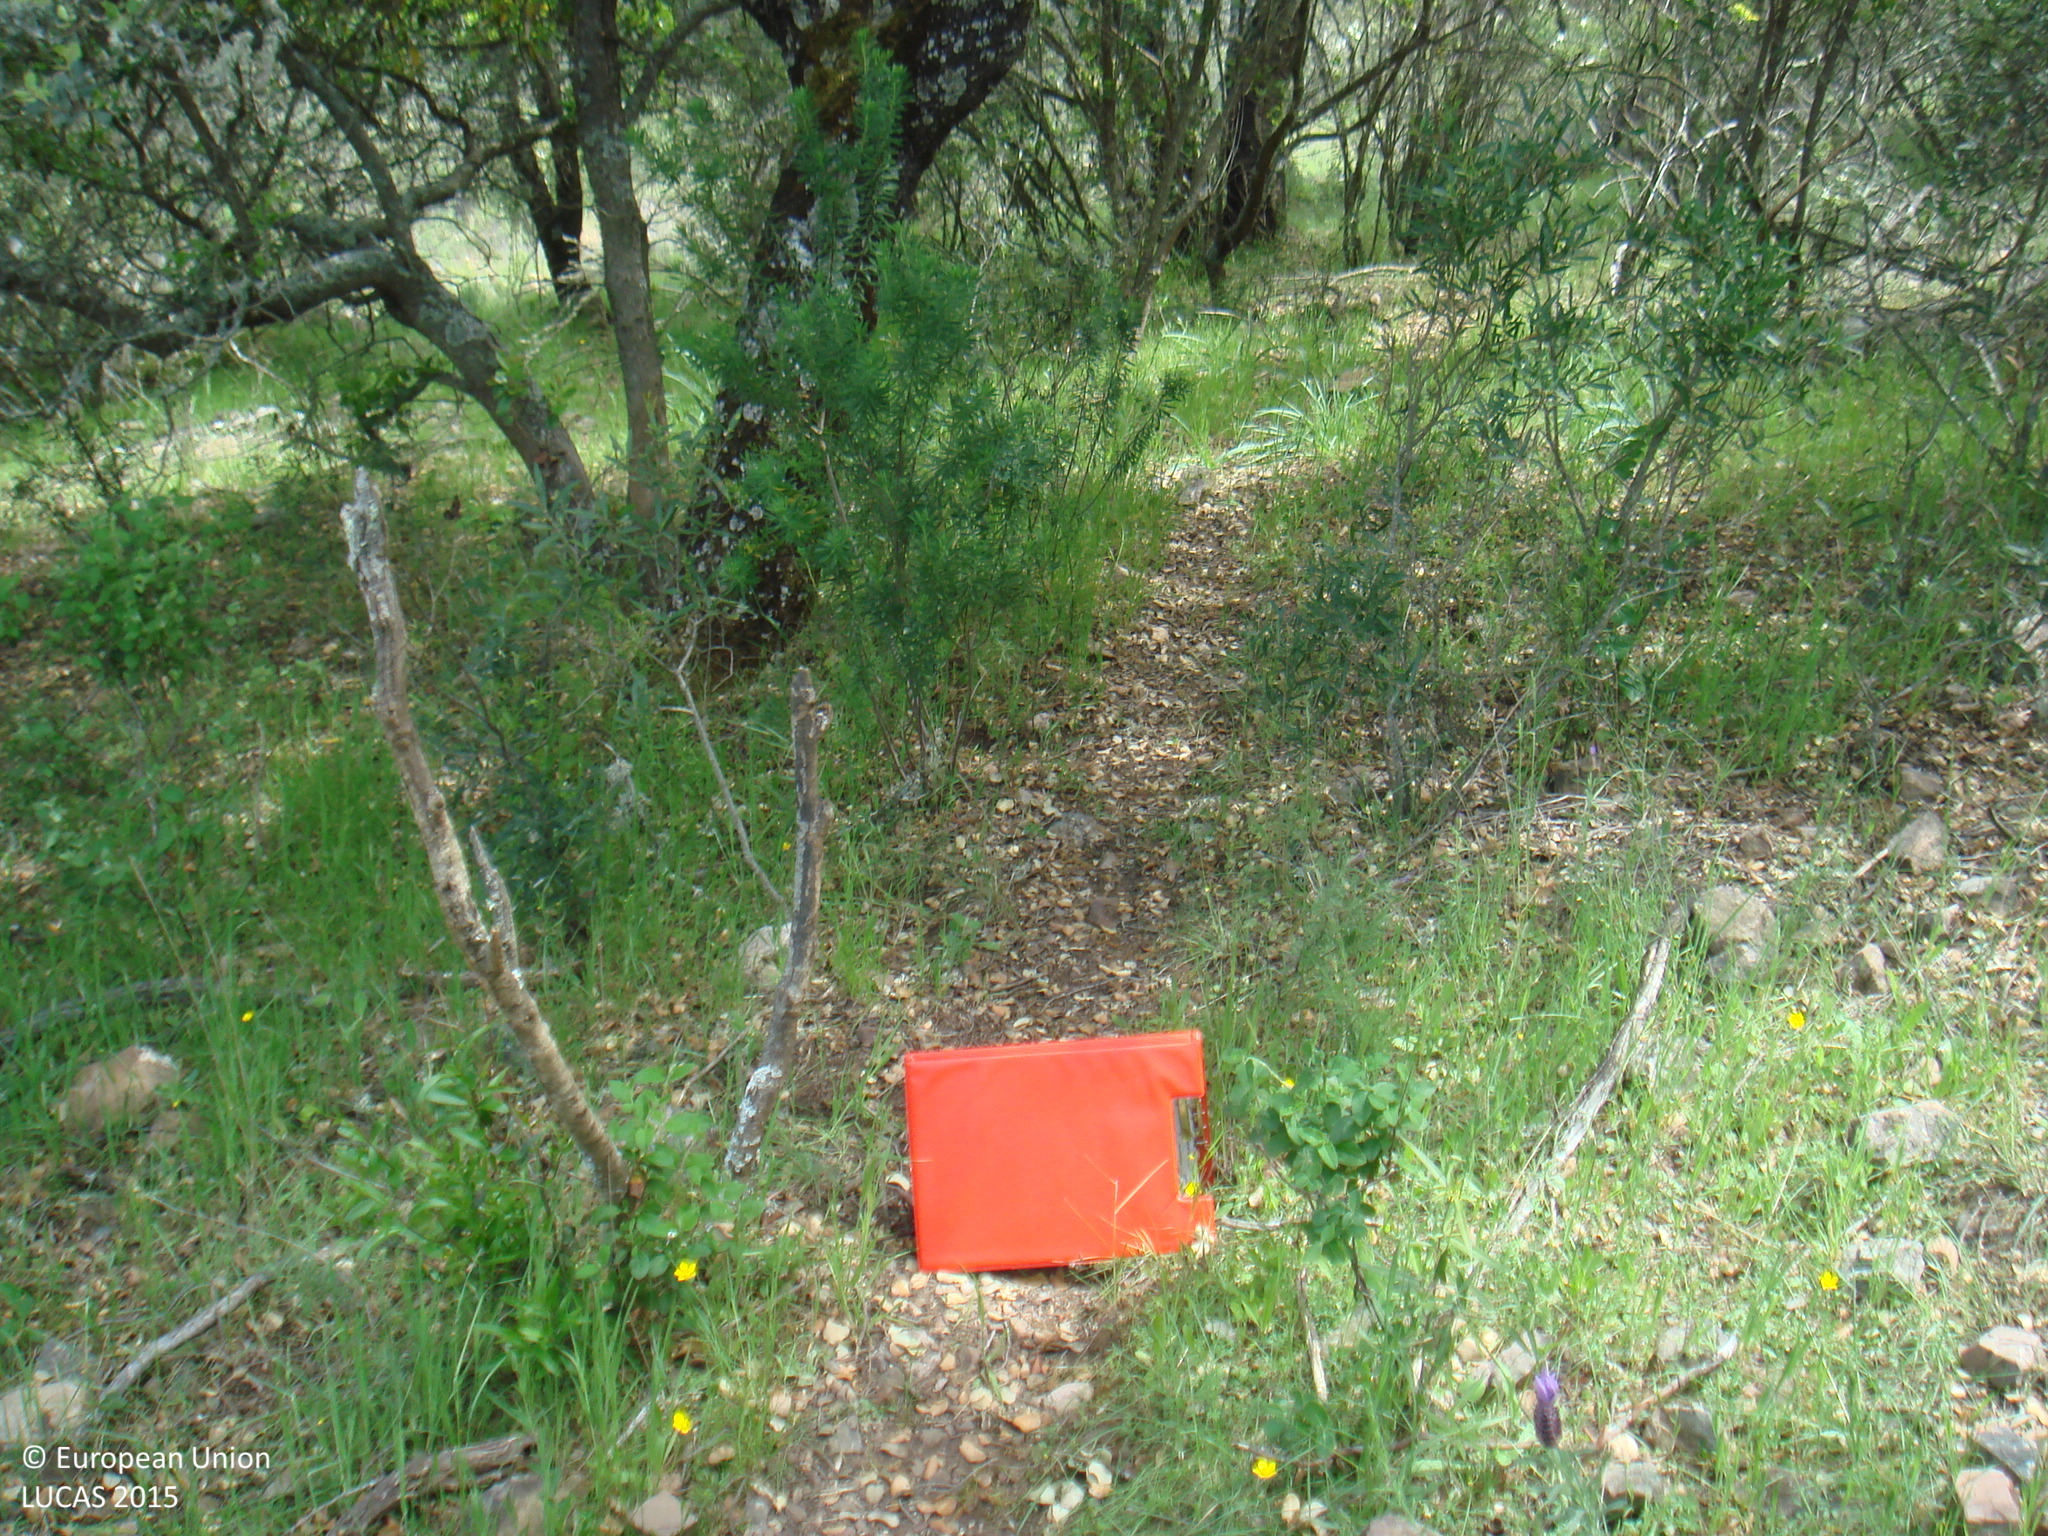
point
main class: Woodland
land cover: Broadleaved woodland
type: broadleaved evergreen forest
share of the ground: 25 - 50 %
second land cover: Shrubland without tree cover
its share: 50 - 75 %
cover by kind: shrubs 50 %, broadleaved forest trees 40 %, herbaceous plants 10 %
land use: Forestry
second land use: Agriculture (excluding fallow land and kitchen gardens)
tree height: > 5 m
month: May
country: ES
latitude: 38.3207
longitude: -5.0899
